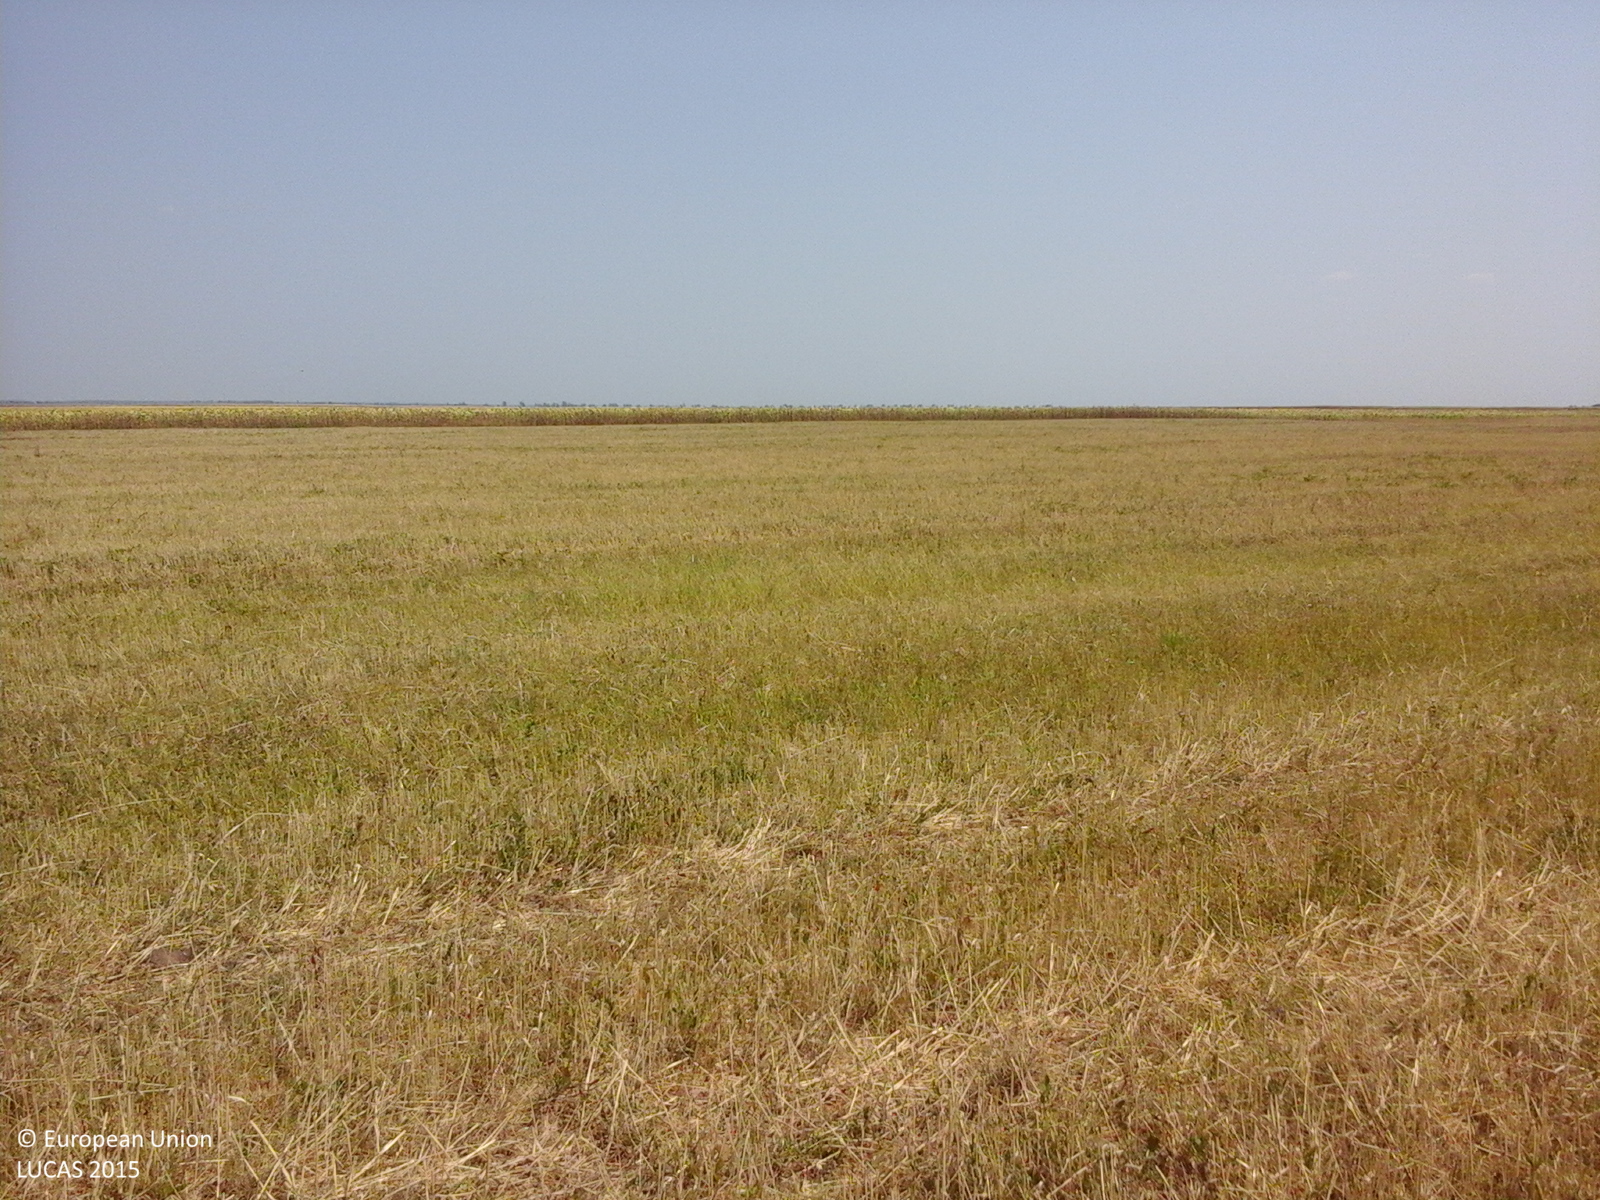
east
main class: Cropland
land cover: Sunflower
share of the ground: > 75 %
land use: Agriculture (excluding fallow land and kitchen gardens)
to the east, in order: Sunflower; Grass margins; Tracks; Grass margins; Common wheat
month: August
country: RO
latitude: 44.2522
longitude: 23.3367
